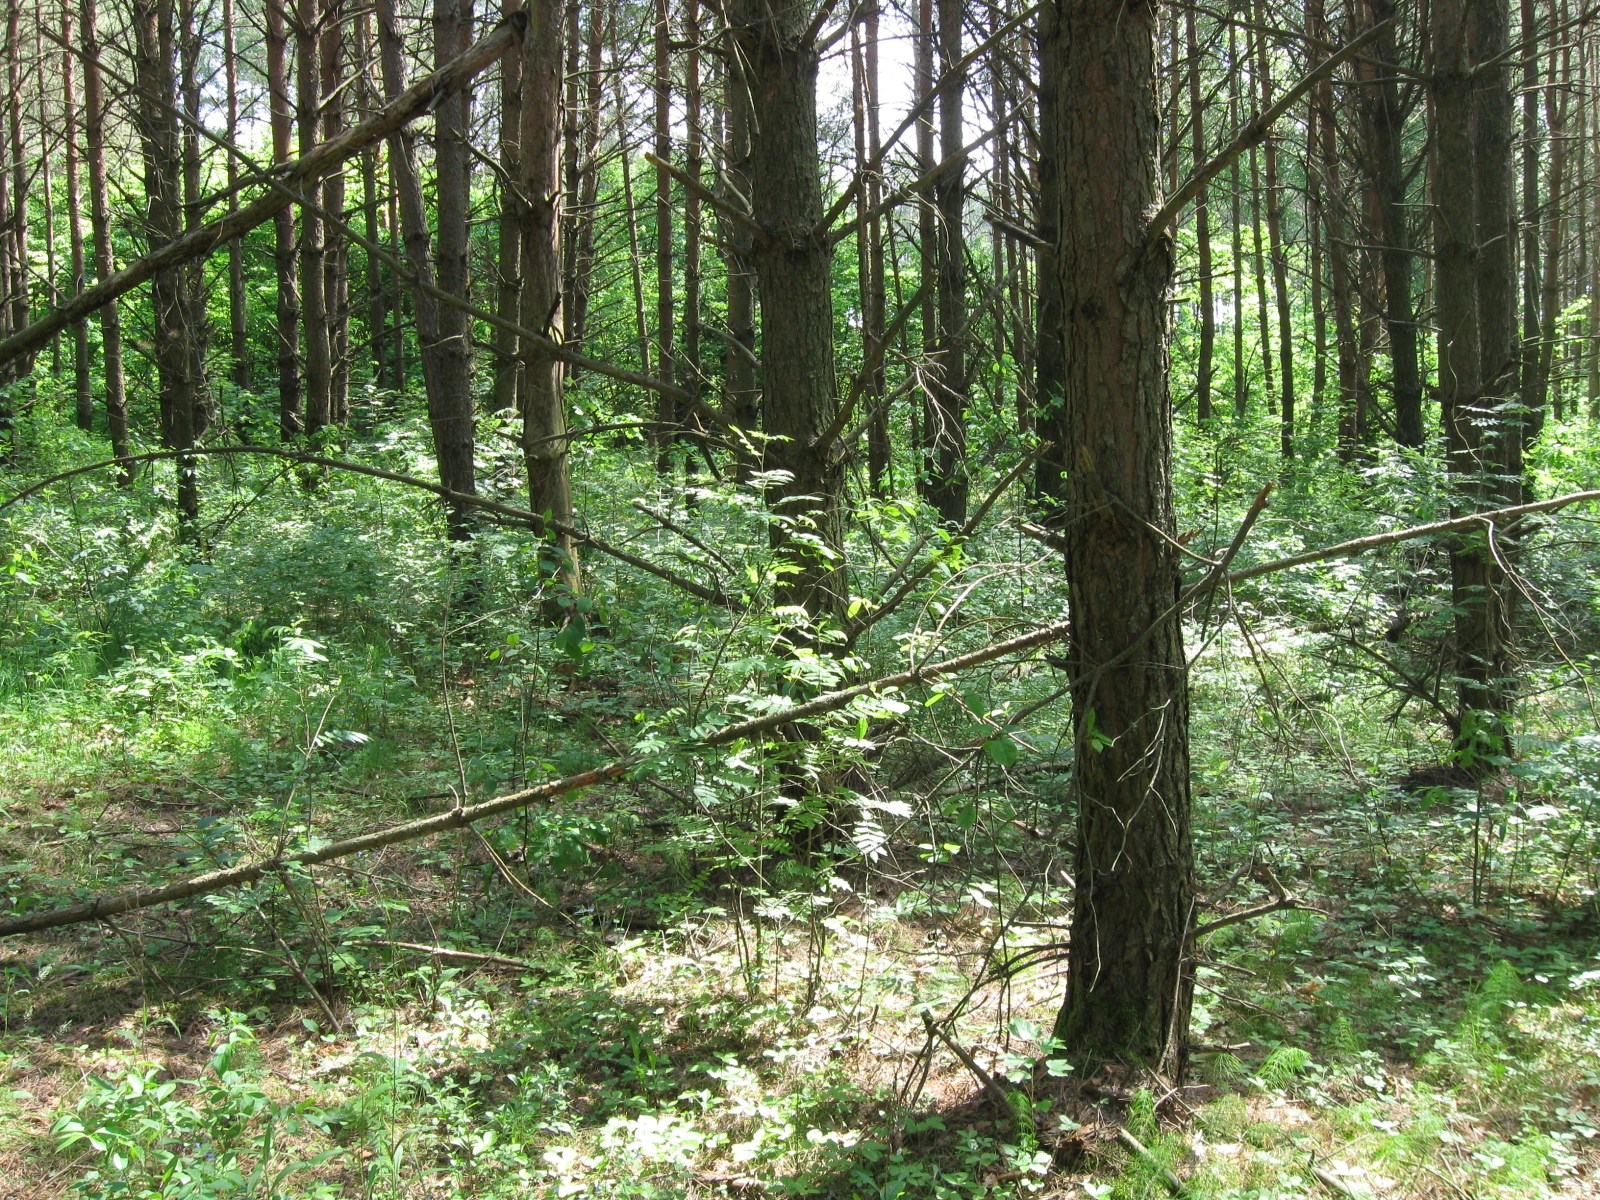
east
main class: Woodland
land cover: Pine dominated coniferous woodland
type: hemiboreal forest and nemoral coniferous forest and mixed broadleaved-coniferous forest
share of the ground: > 75 %
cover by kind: coniferous forest trees 85 %, broadleaved forest trees 10 %, herbaceous plants 5 %
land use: Forestry
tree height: > 5 m
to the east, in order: Pine dominated coniferous woodland; Pine dominated mixed woodland; Grassland without tree/shrub cover; Pine dominated mixed woodland; Pine dominated coniferous woodland; Grassland with sparse tree/shrub cover; Tracks; Grassland with sparse tree/shrub cover; Other mixed woodland
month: June
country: LT
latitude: 54.2012
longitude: 23.7462
